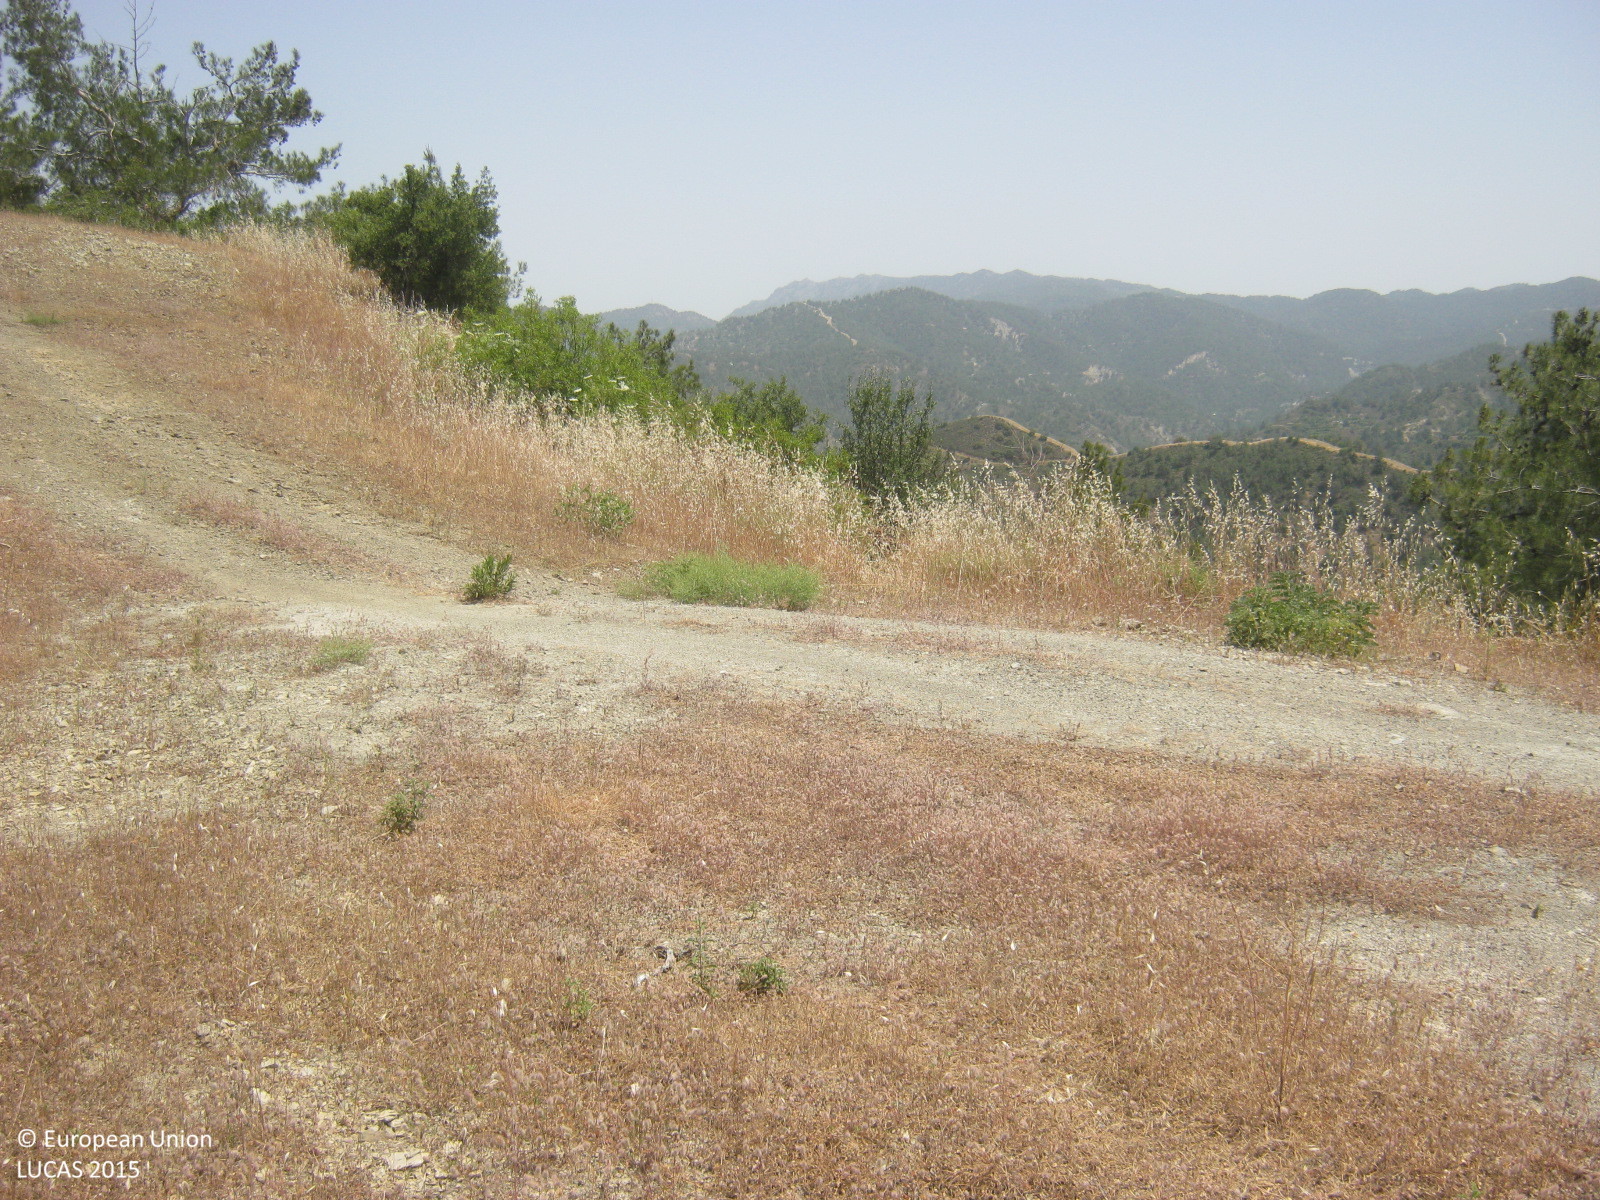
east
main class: Woodland
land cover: Pine dominated coniferous woodland
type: coniferous forest of the mediterranean region
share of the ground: > 75 %
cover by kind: coniferous forest trees 75 %, shrubs 15 %, unconsolidated bare surface 10 %
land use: Forestry
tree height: > 5 m
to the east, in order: Pine dominated coniferous woodland; Shrubland without tree cover; Pine dominated coniferous woodland
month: May
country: CY
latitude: 34.9932
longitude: 32.8805
